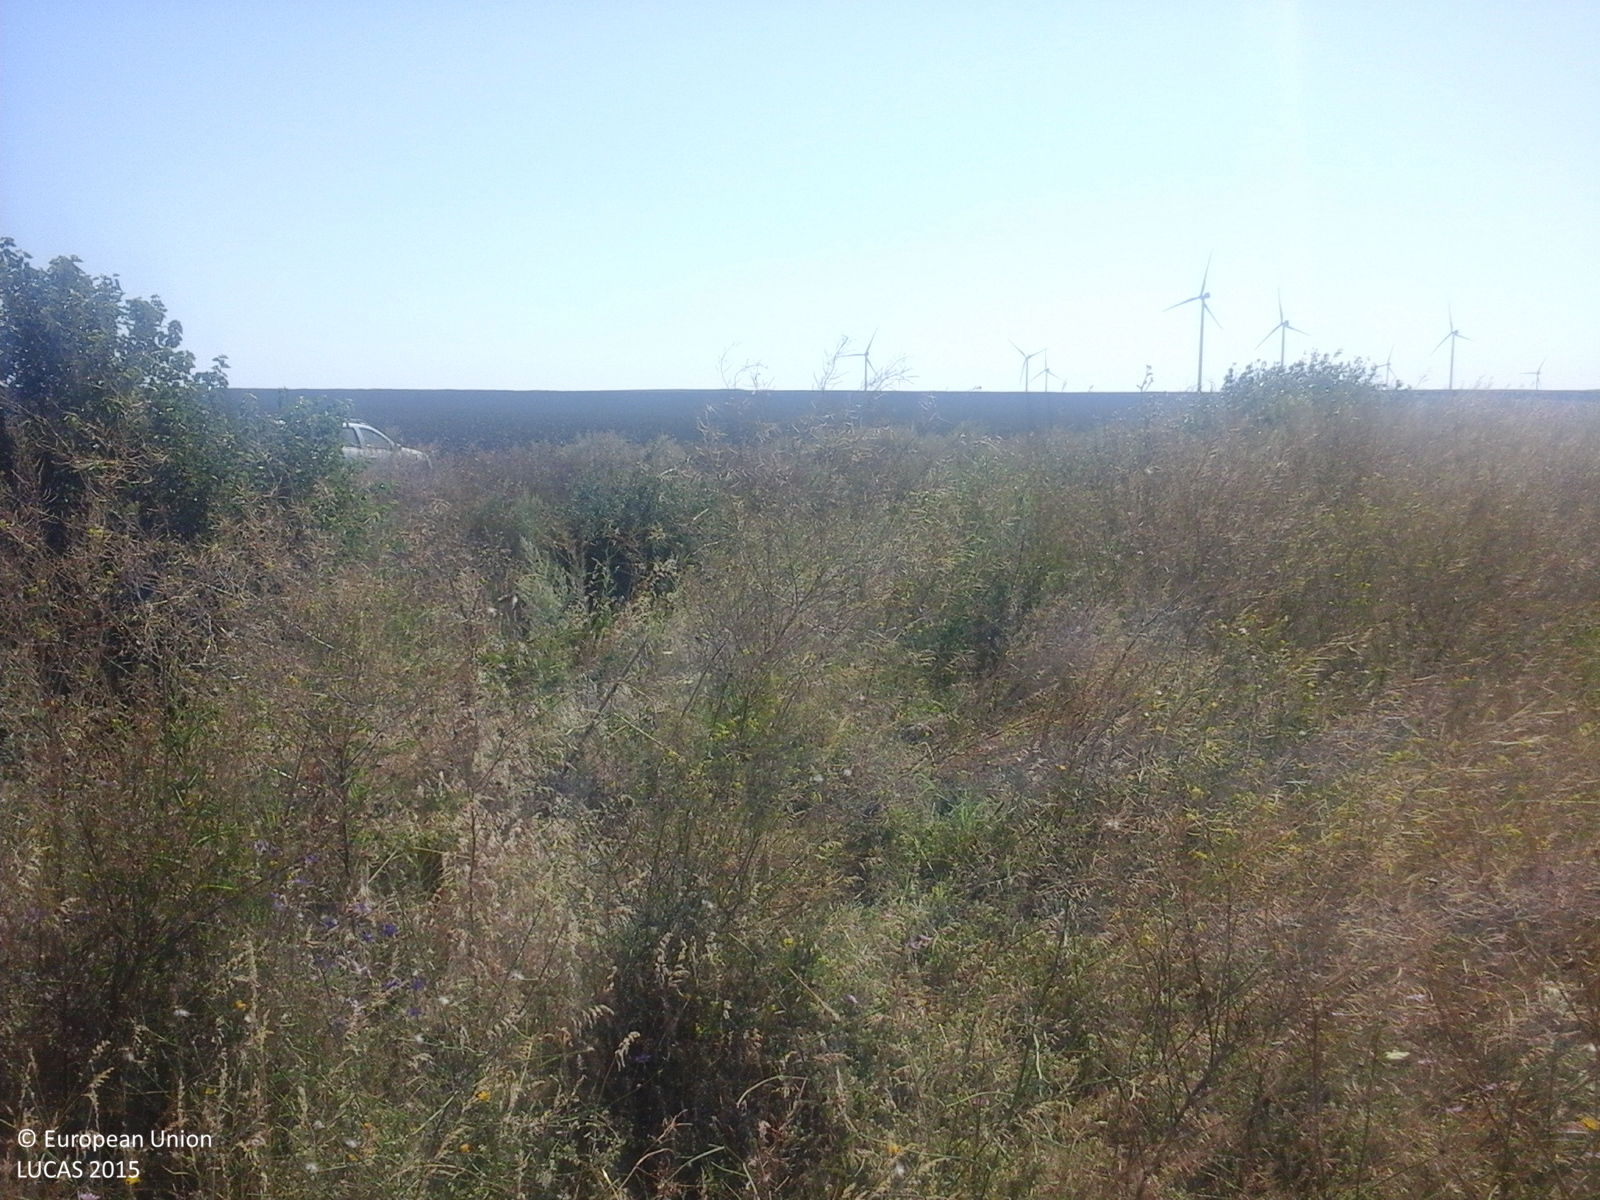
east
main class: Cropland
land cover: Maize
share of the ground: > 75 %
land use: Agriculture (excluding fallow land and kitchen gardens)
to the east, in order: Maize; Spontaneously vegetated surfaces; Ditches and canals; Spontaneously vegetated surfaces; Tracks; Grass margins; Common wheat
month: August
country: RO
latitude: 44.6203
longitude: 28.2263
